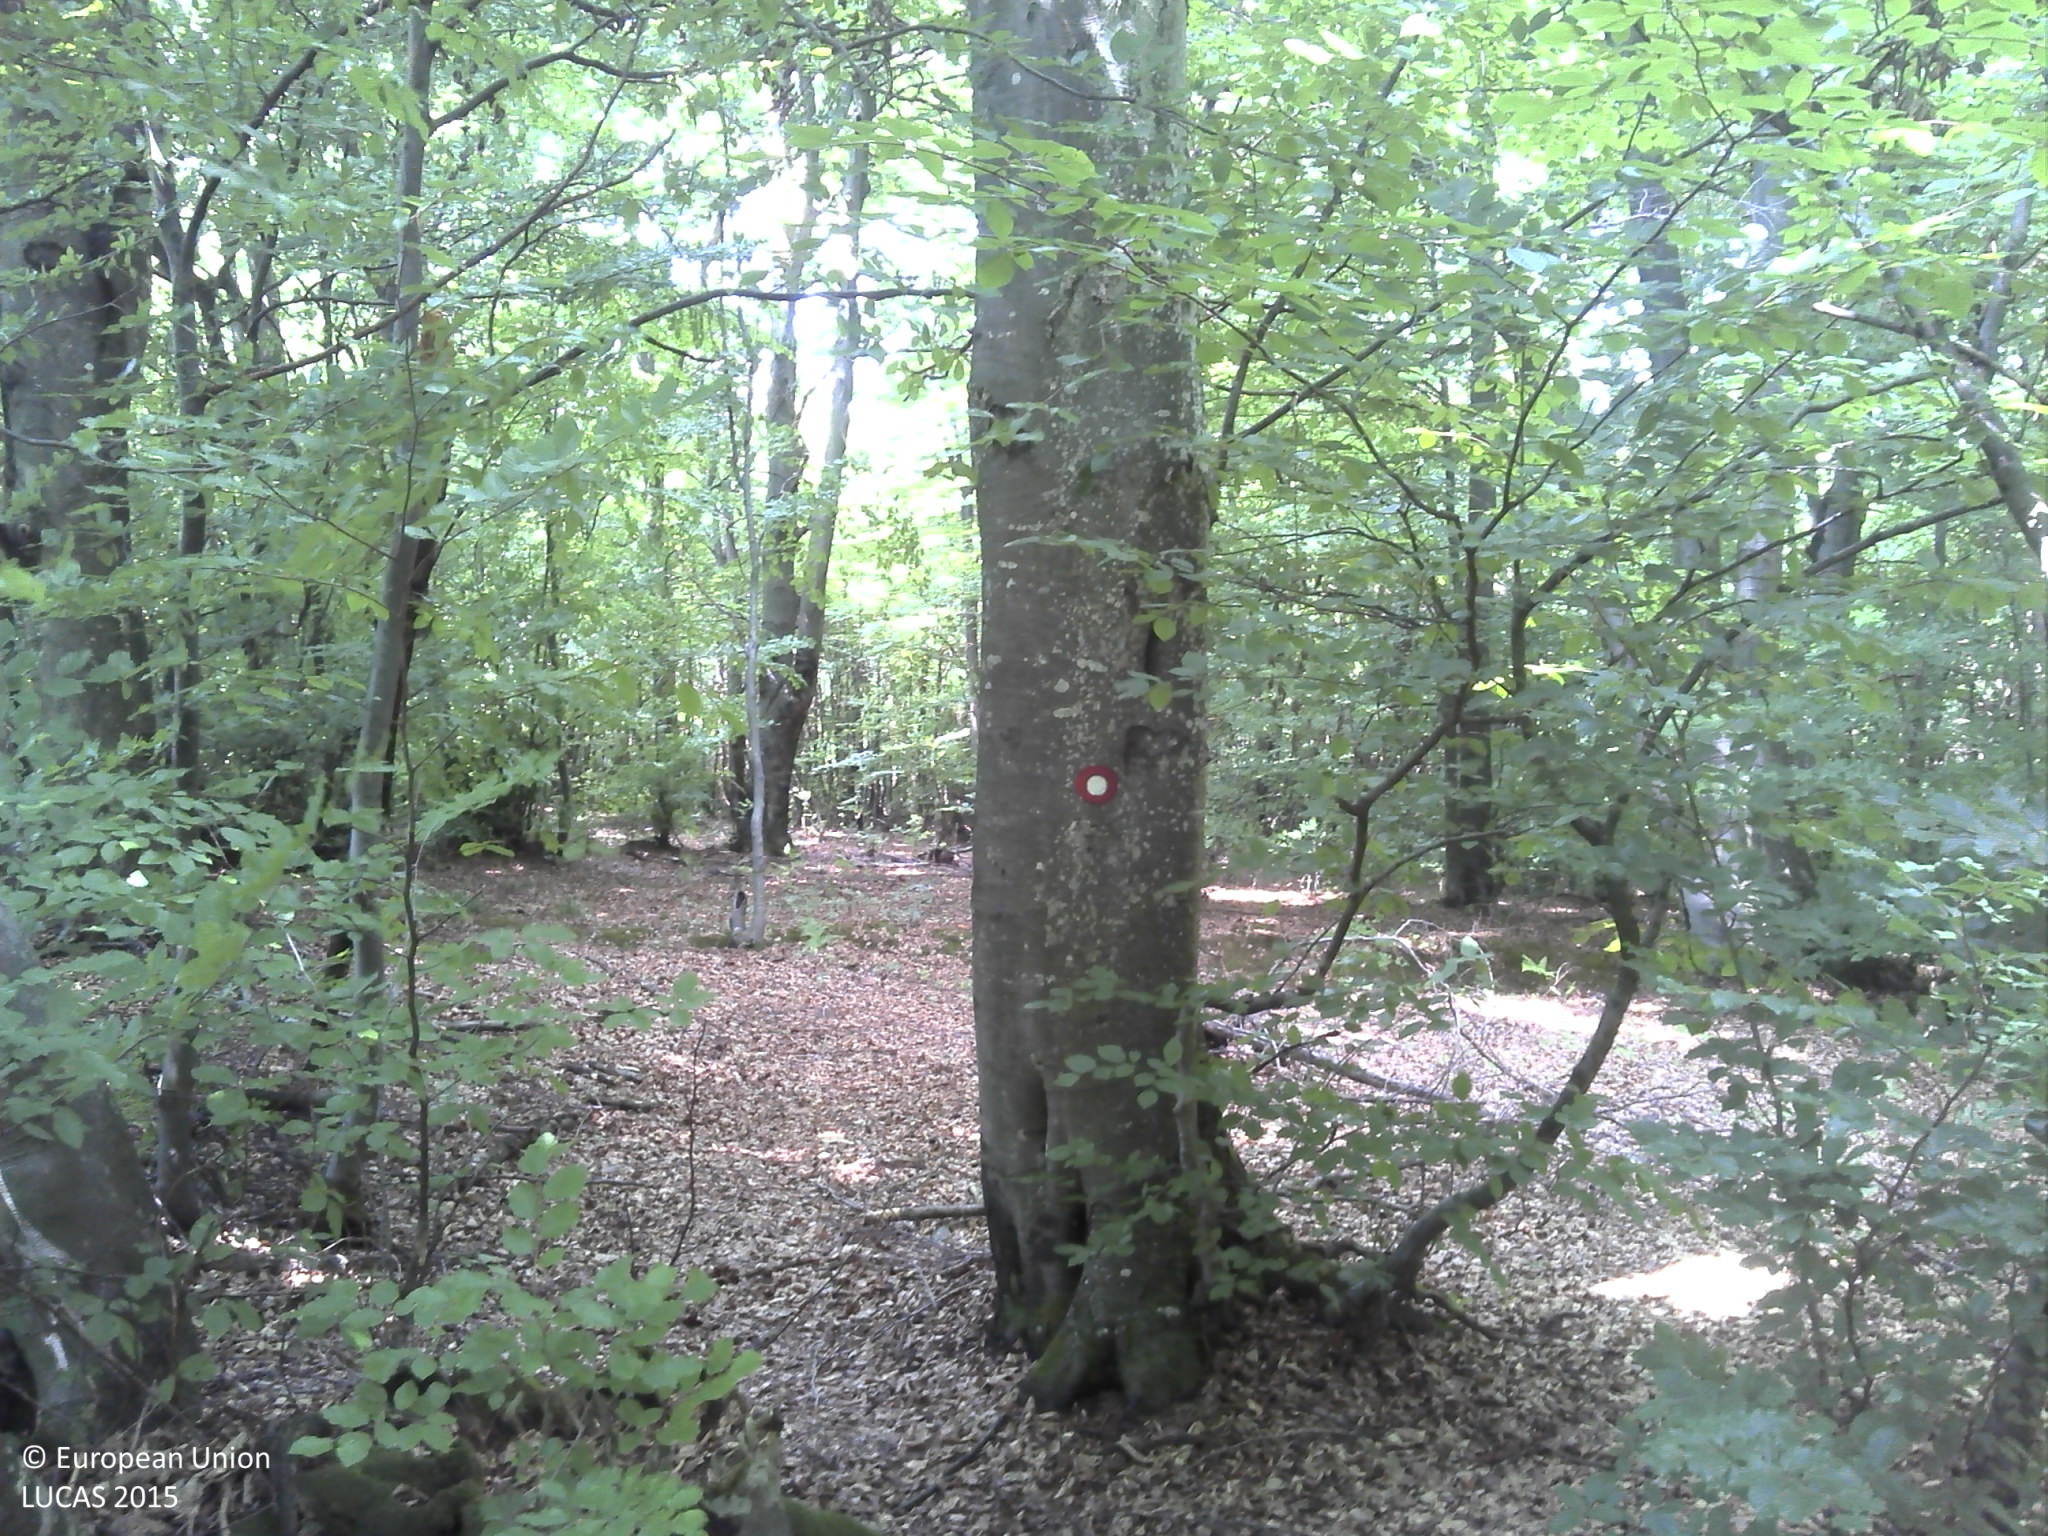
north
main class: Woodland
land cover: Broadleaved woodland
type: beech forest
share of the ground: > 75 %
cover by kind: broadleaved forest trees 80 %, lichens and mosses 20 %
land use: Forestry
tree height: > 5 m
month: June
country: HR
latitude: 45.3839
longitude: 17.2159
